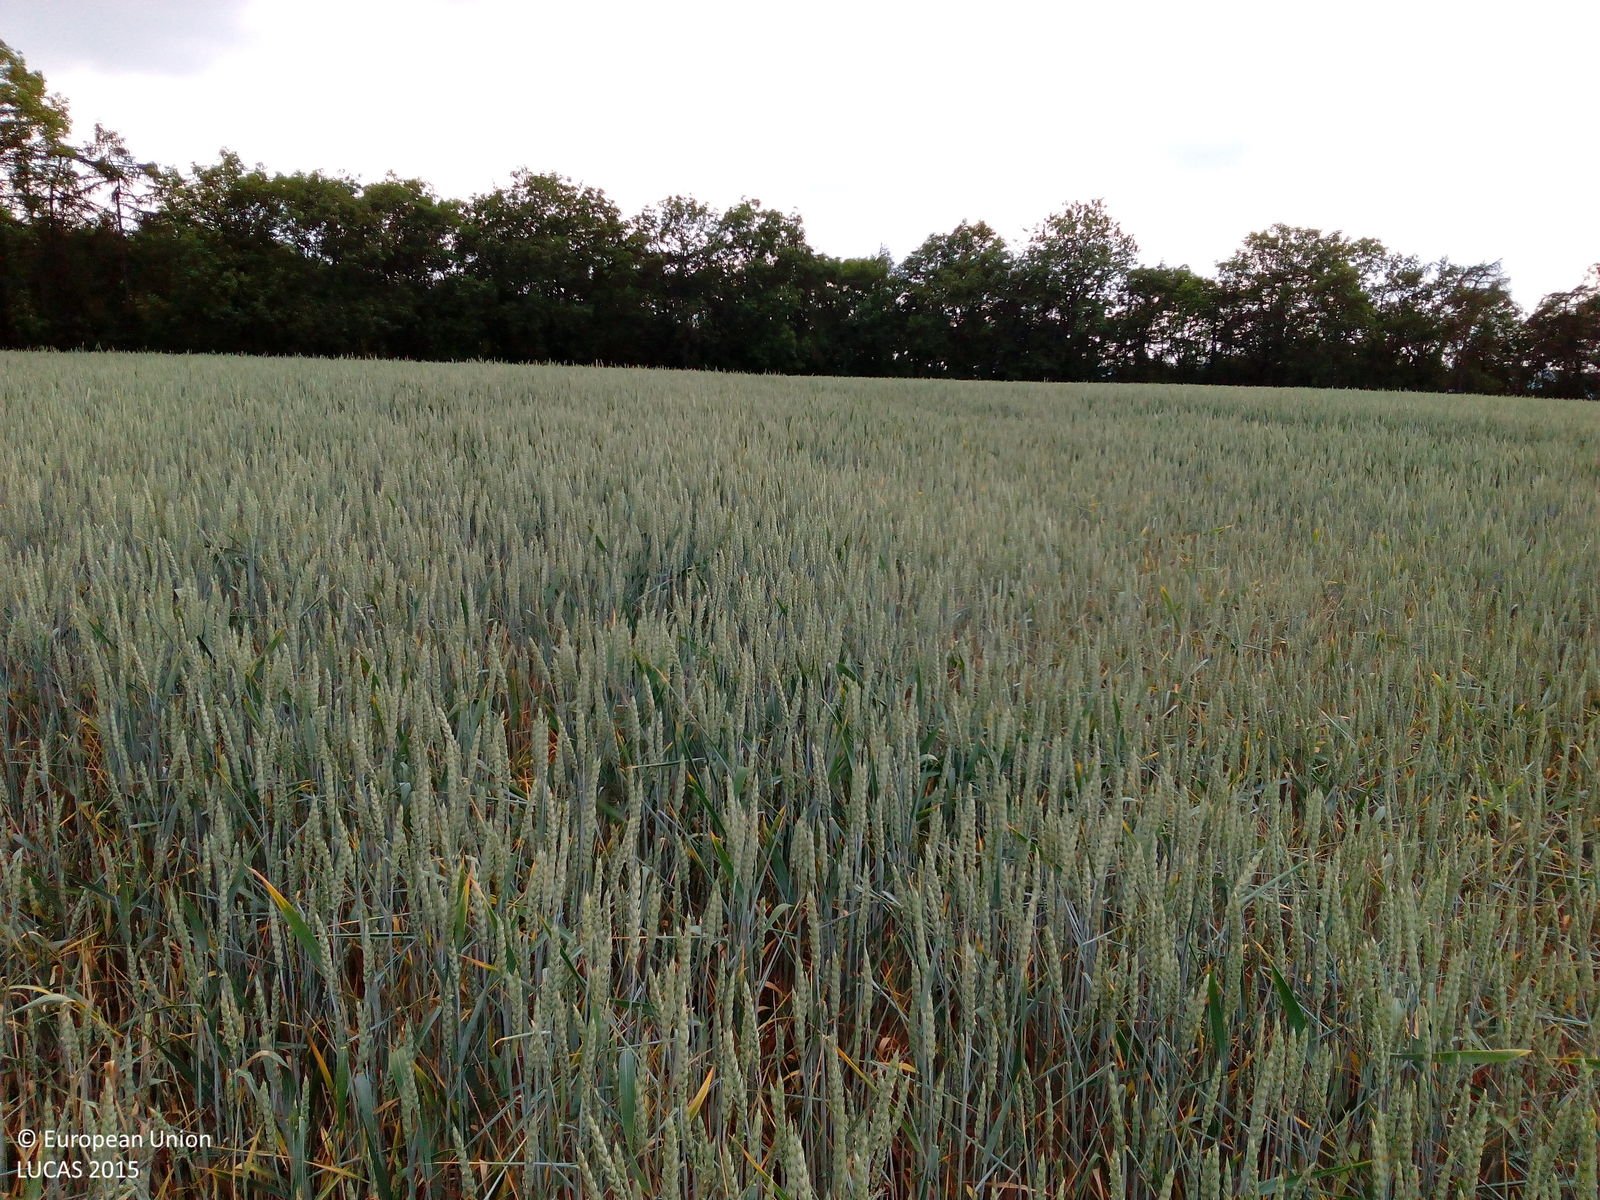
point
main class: Cropland
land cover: Common wheat
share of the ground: > 75 %
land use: Agriculture (excluding fallow land and kitchen gardens)
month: June
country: DE
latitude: 50.6938
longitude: 11.6559
